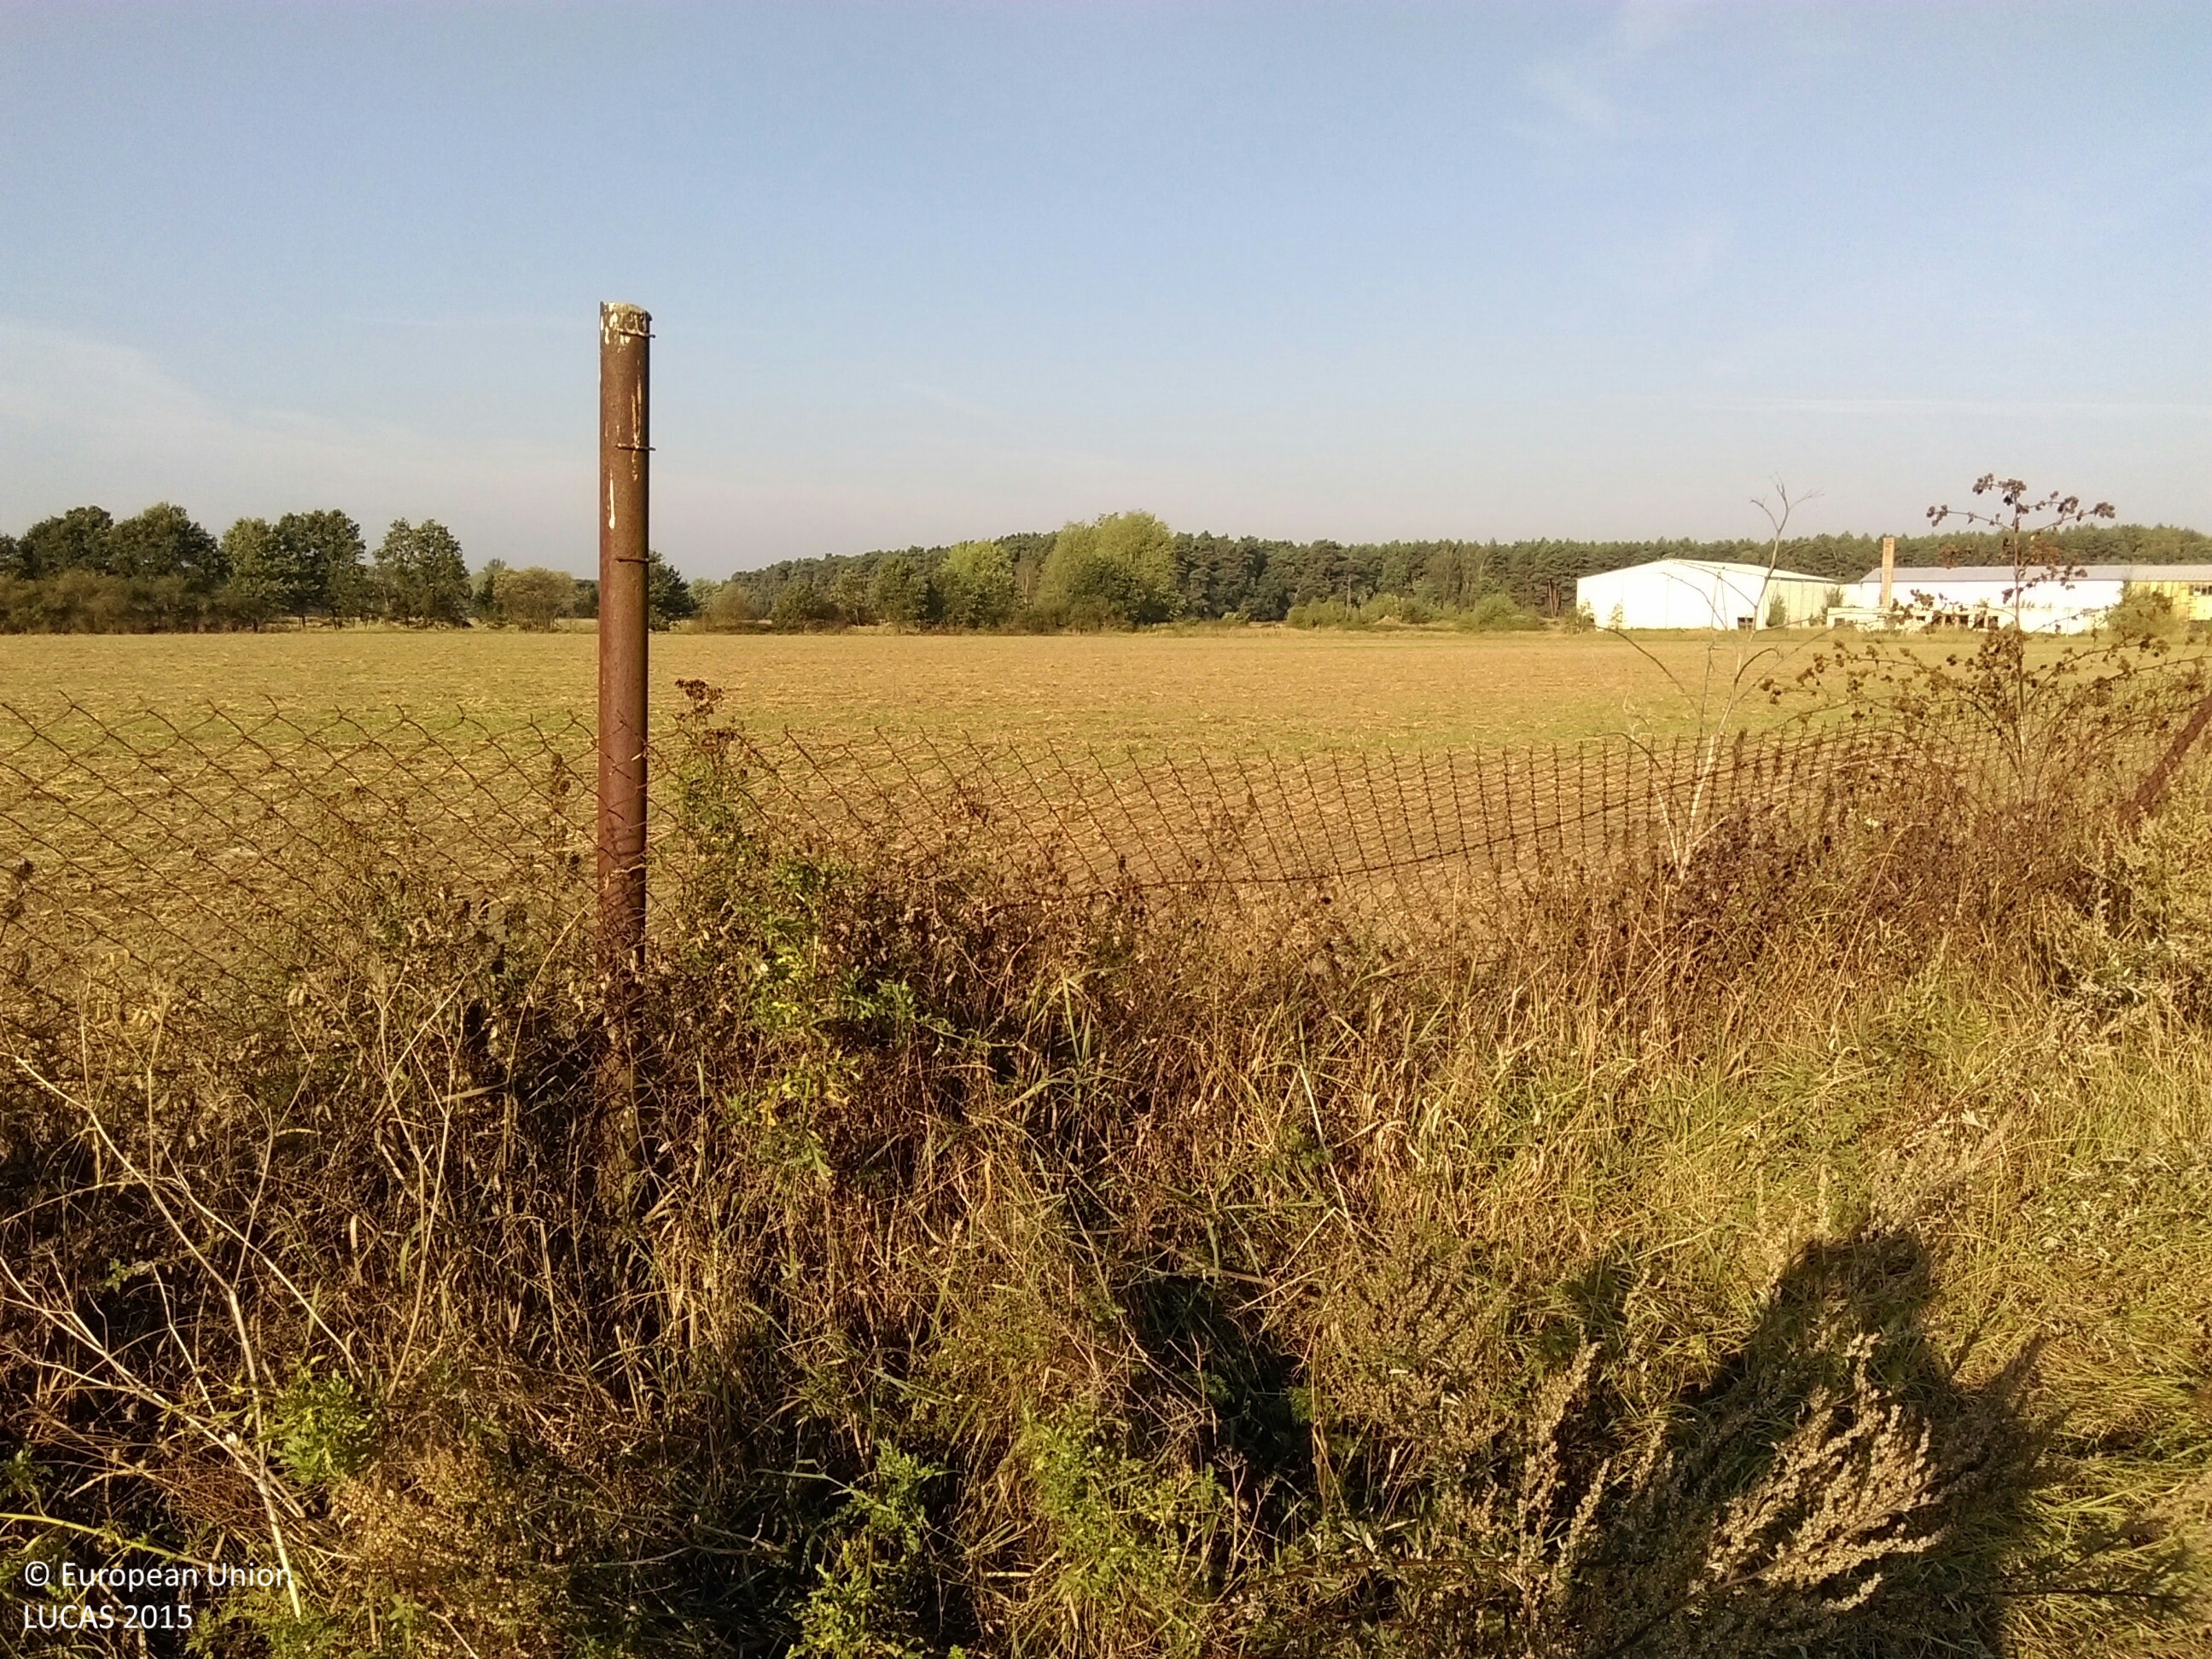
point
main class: Cropland
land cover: Triticale
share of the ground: < 10 %
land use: Agriculture (excluding fallow land and kitchen gardens)
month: September
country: PL
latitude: 51.7969
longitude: 15.5579
